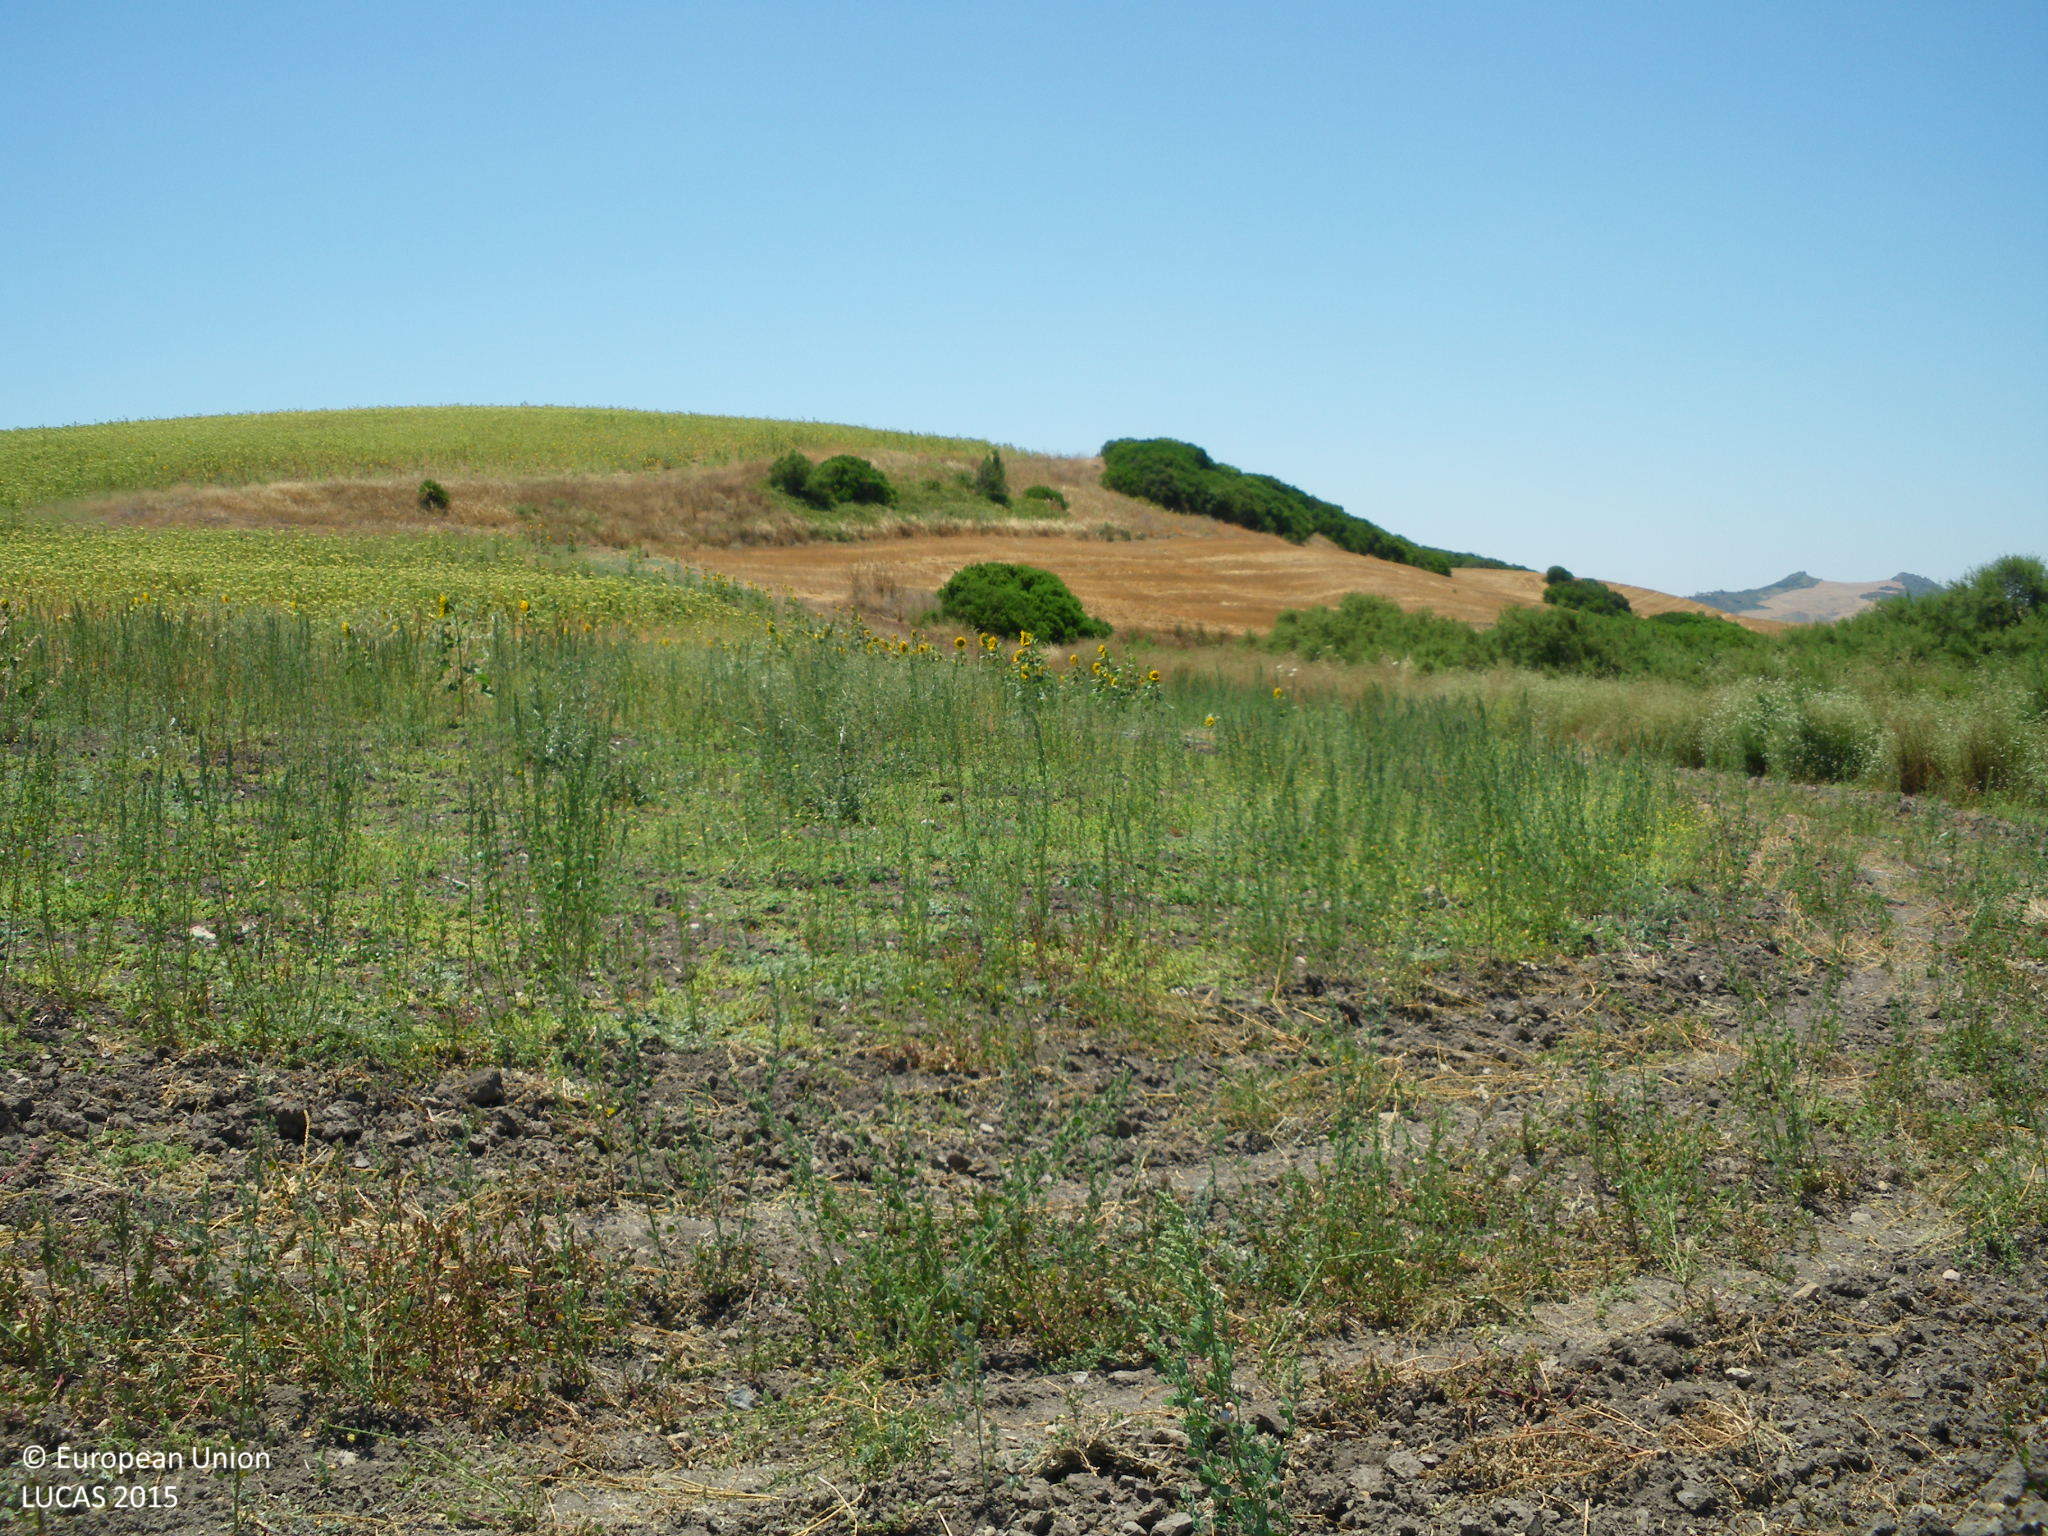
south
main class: Grassland
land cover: Grassland without tree/shrub cover
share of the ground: > 75 %
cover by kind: herbaceous plants 100 %
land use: Semi-natural and natural areas not in use
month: June
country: ES
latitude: 36.9006
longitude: -5.7784
